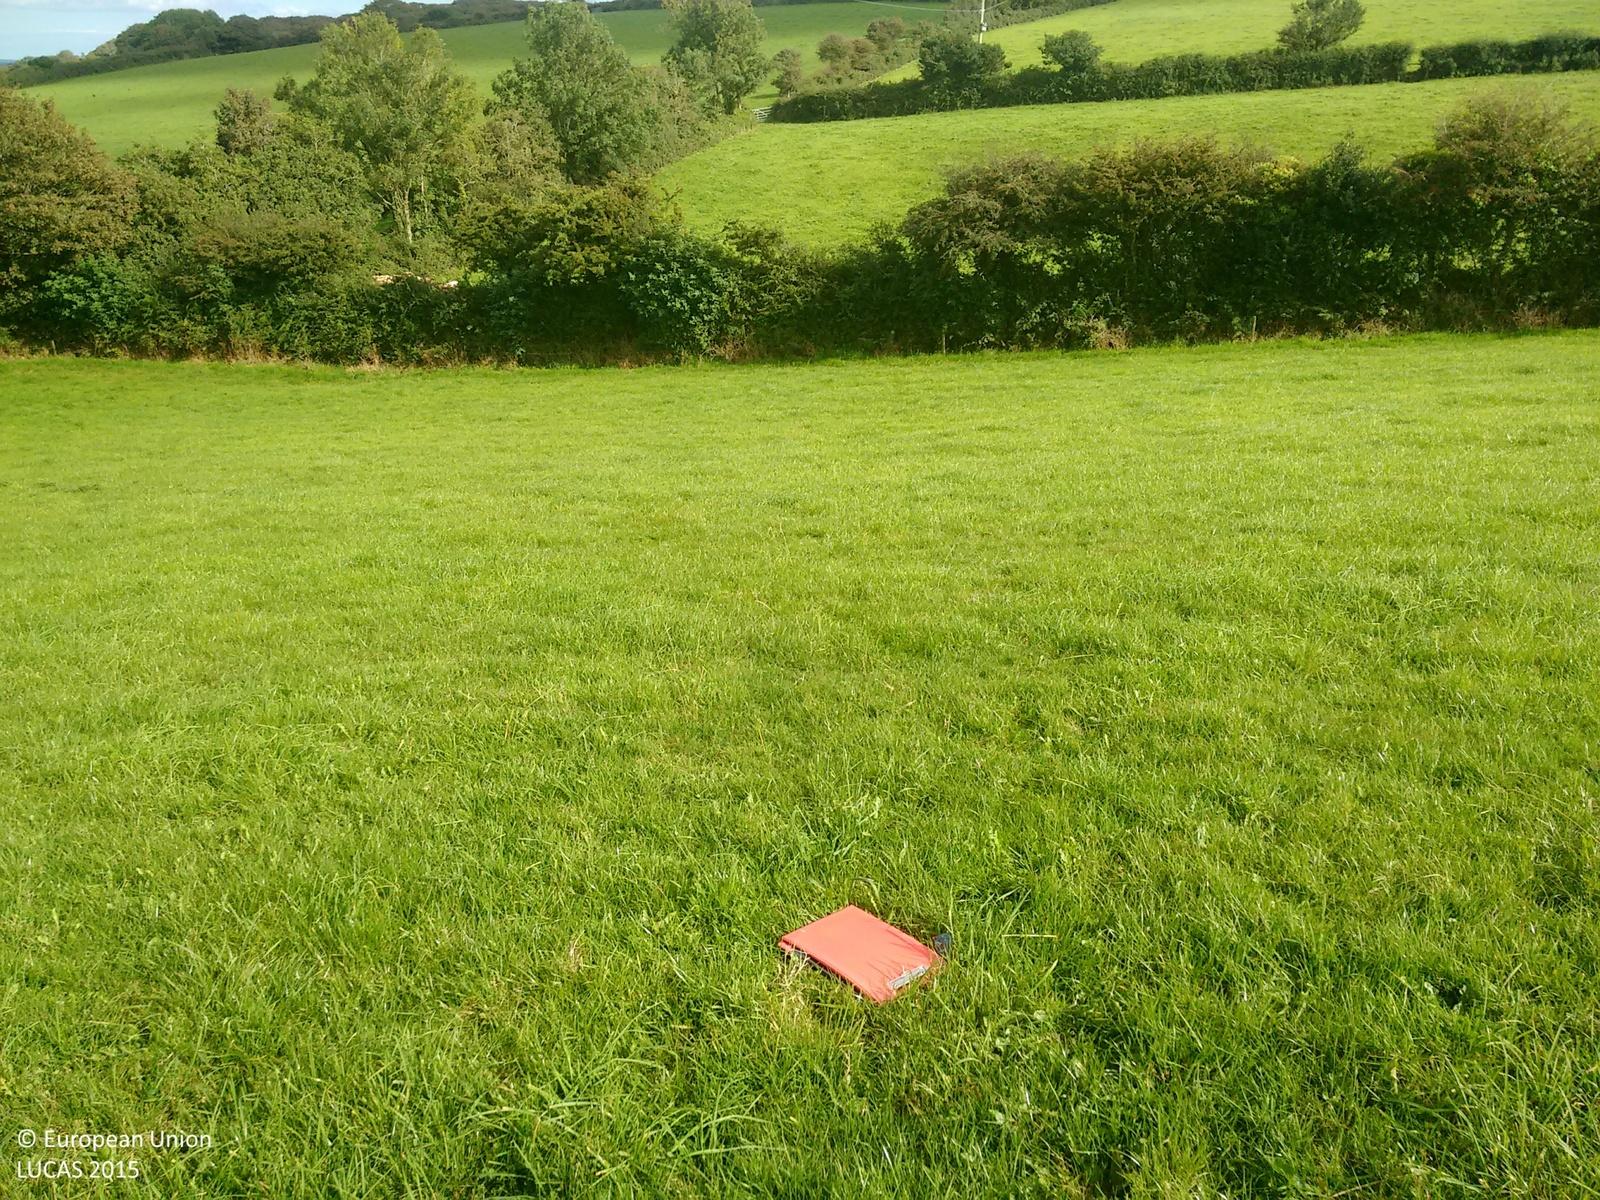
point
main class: Grassland
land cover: Grassland without tree/shrub cover
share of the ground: > 75 %
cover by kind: herbaceous plants 100 %
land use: Agriculture (excluding fallow land and kitchen gardens)
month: September
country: GB
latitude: 50.2031
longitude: -5.1810
